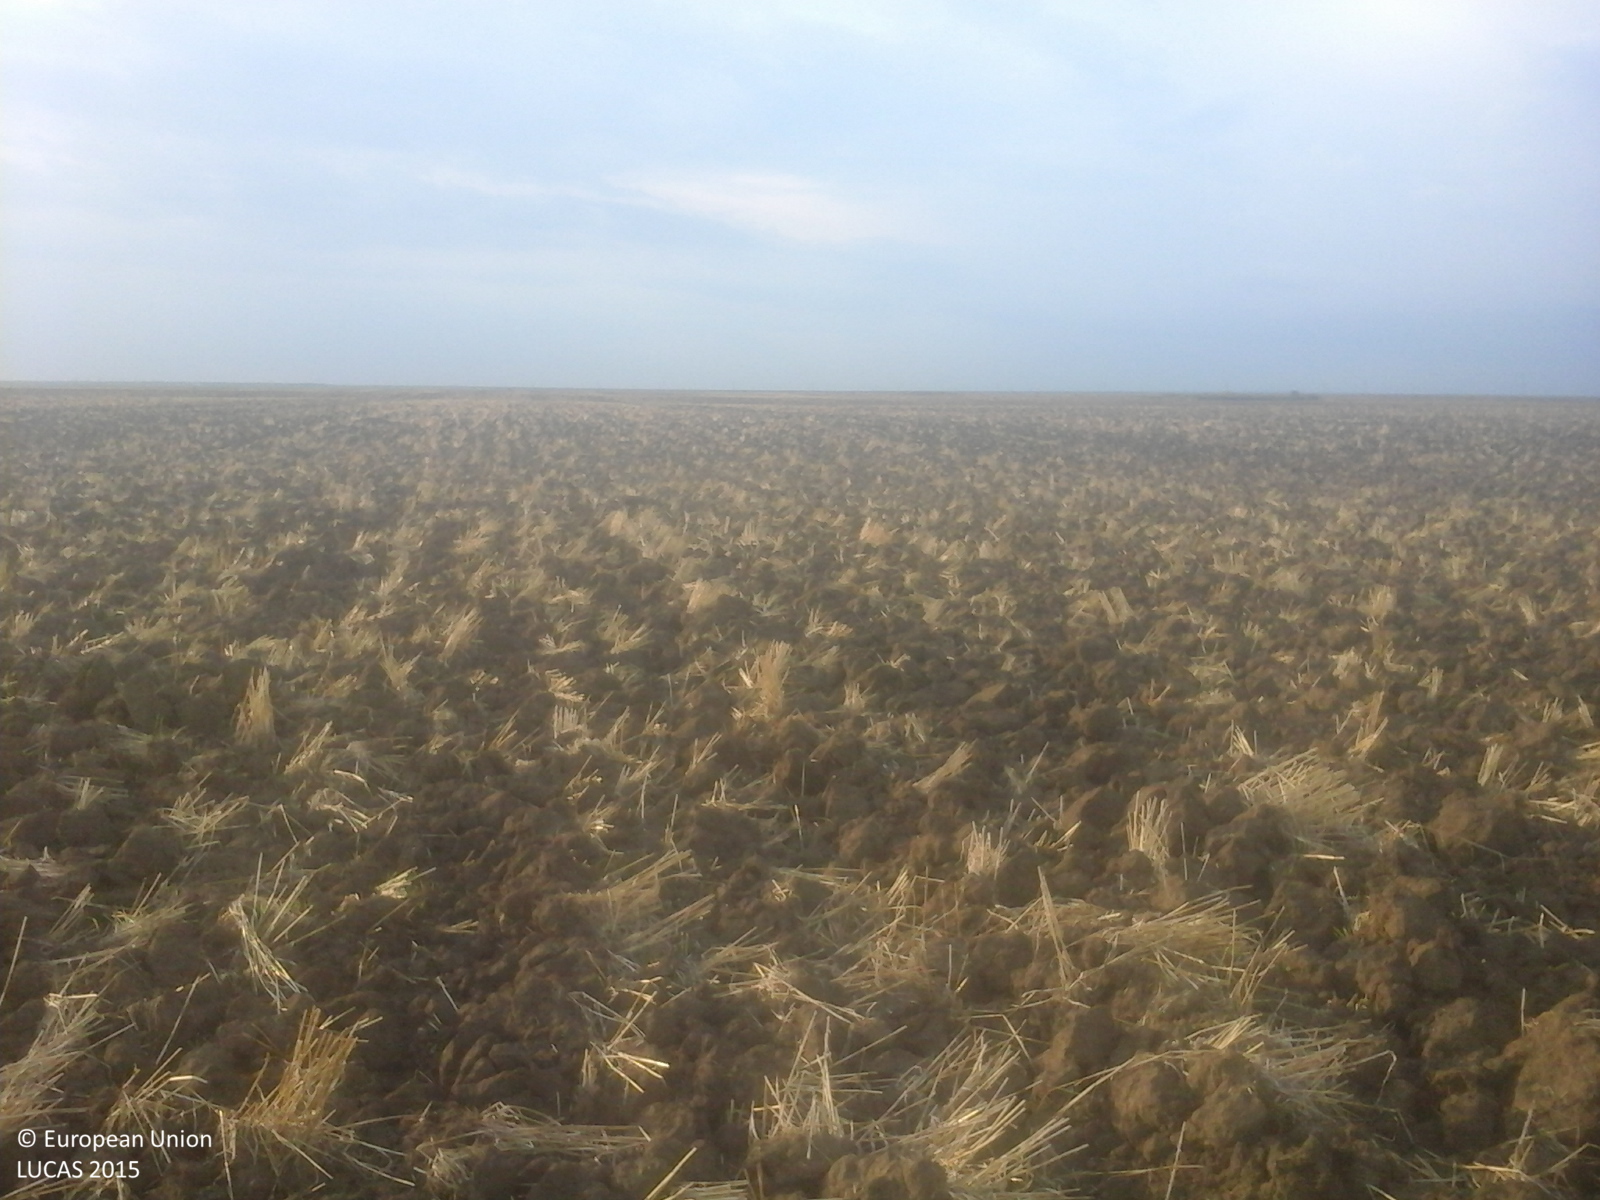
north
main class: Cropland
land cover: Common wheat
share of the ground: < 10 %
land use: Agriculture (excluding fallow land and kitchen gardens)
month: July
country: RO
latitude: 43.8341
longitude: 24.5288
